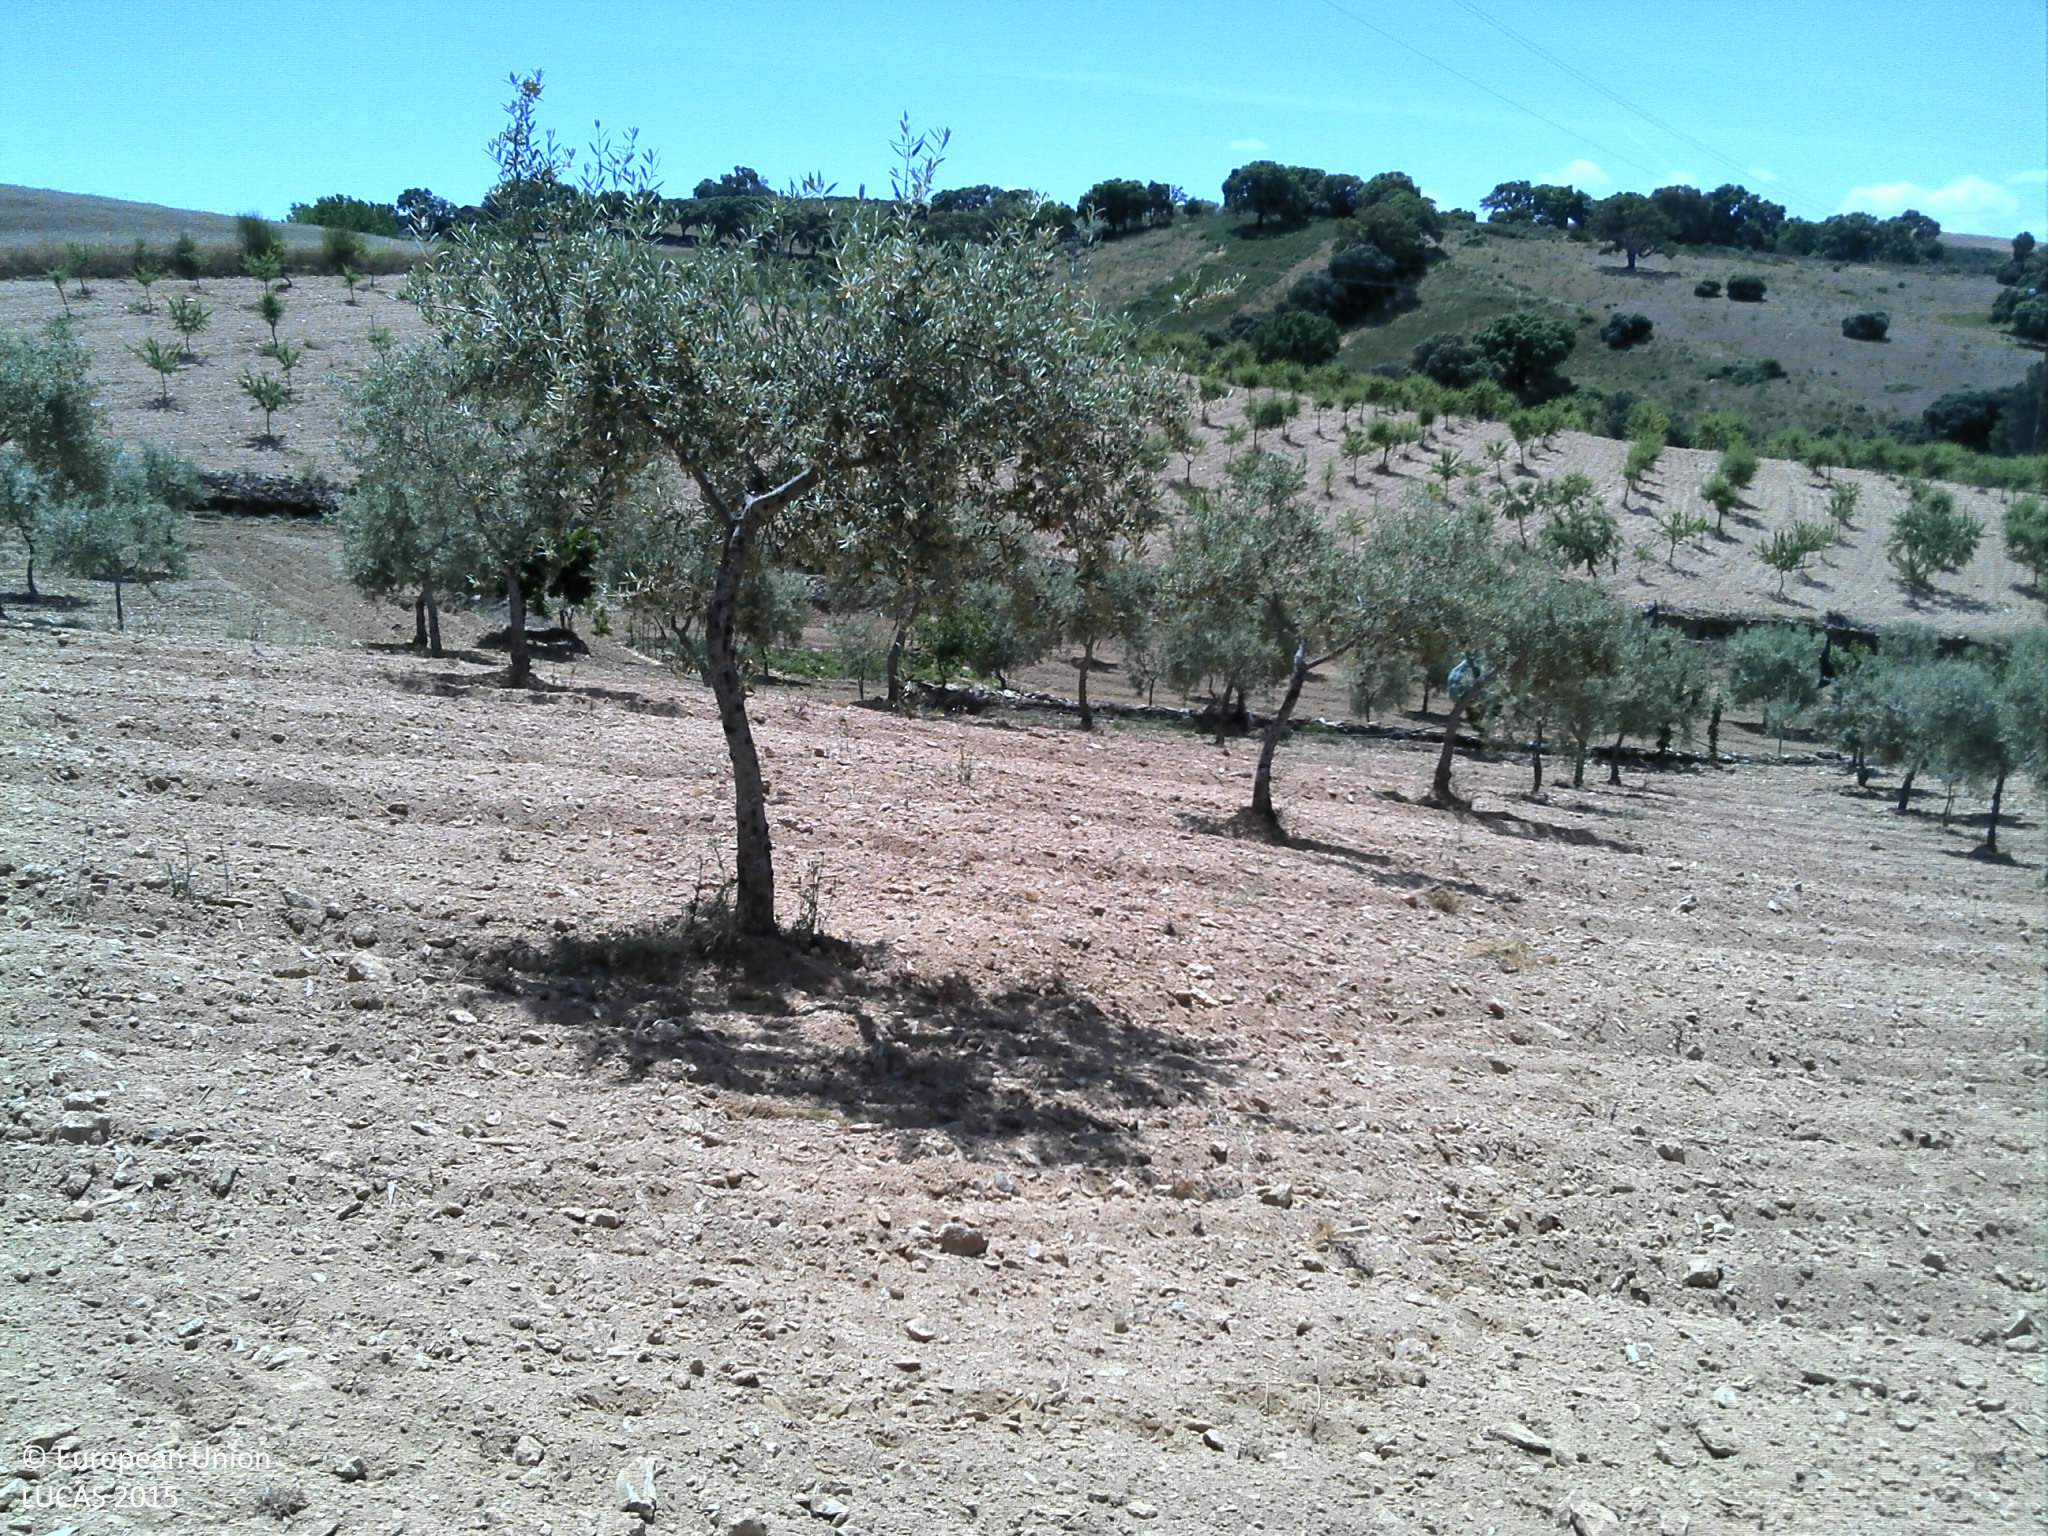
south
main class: Cropland
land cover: Olive groves
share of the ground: 10 - 25 %
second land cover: Other bare soil
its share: > 75 %
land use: Agriculture (excluding fallow land and kitchen gardens)
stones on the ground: 25 - 50 %
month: June
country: PT
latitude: 41.3583
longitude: -6.8557
